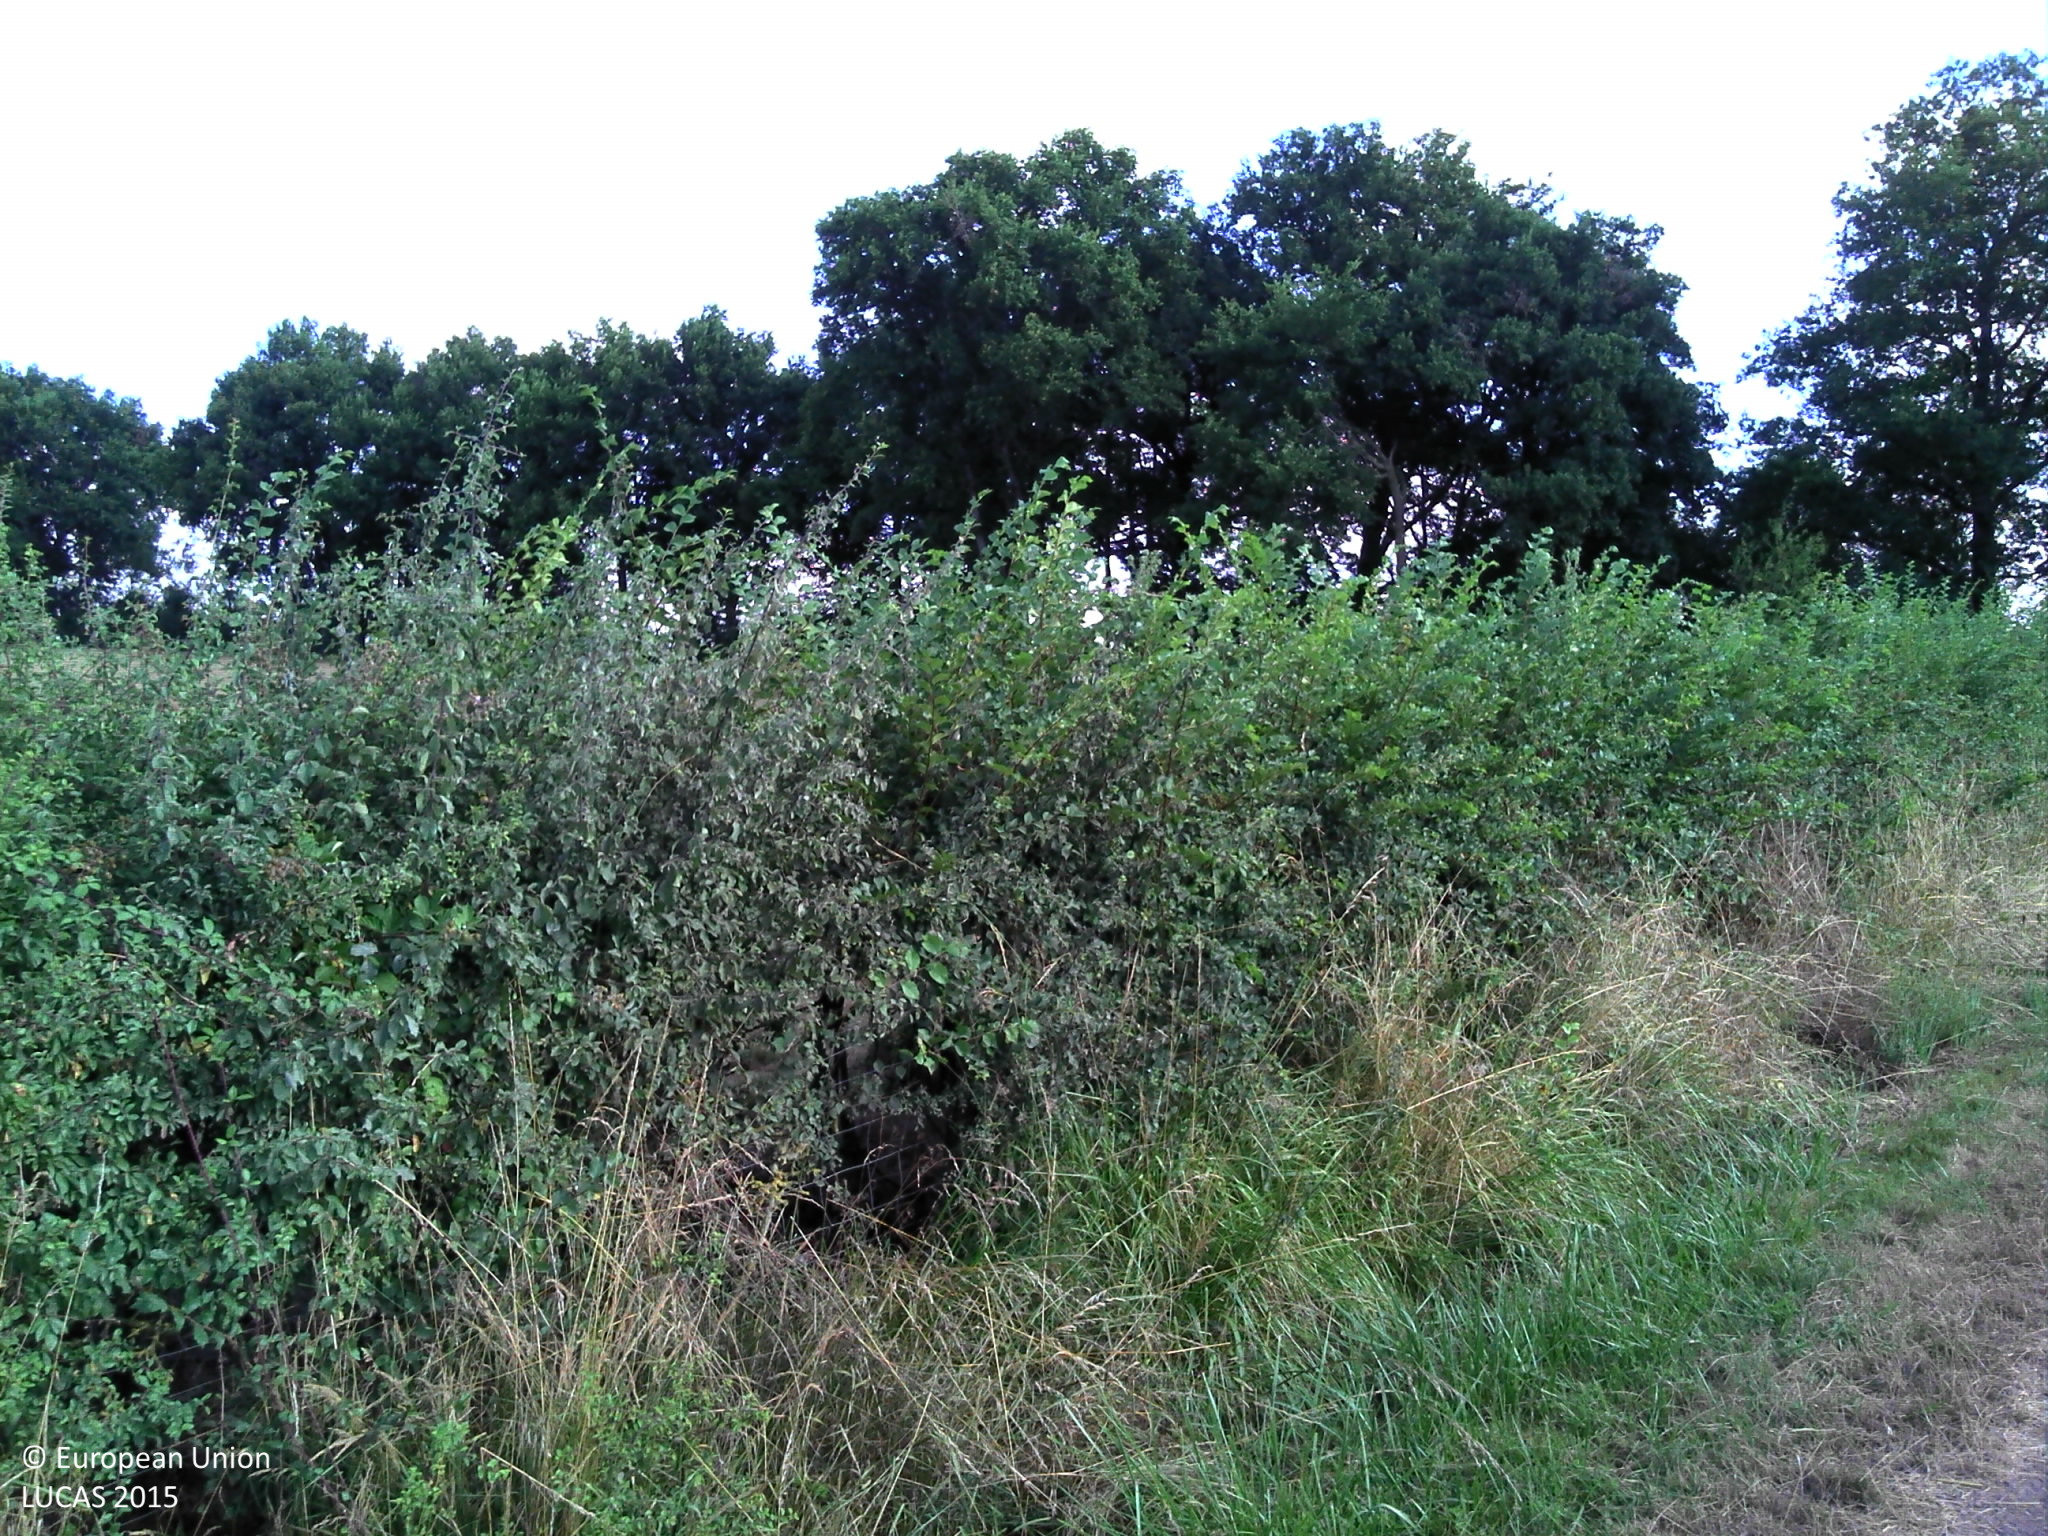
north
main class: Grassland
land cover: Grassland without tree/shrub cover
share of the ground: > 75 %
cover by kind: herbaceous plants 100 %
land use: Agriculture (excluding fallow land and kitchen gardens)
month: July
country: FR
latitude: 46.2183
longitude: 0.5075
